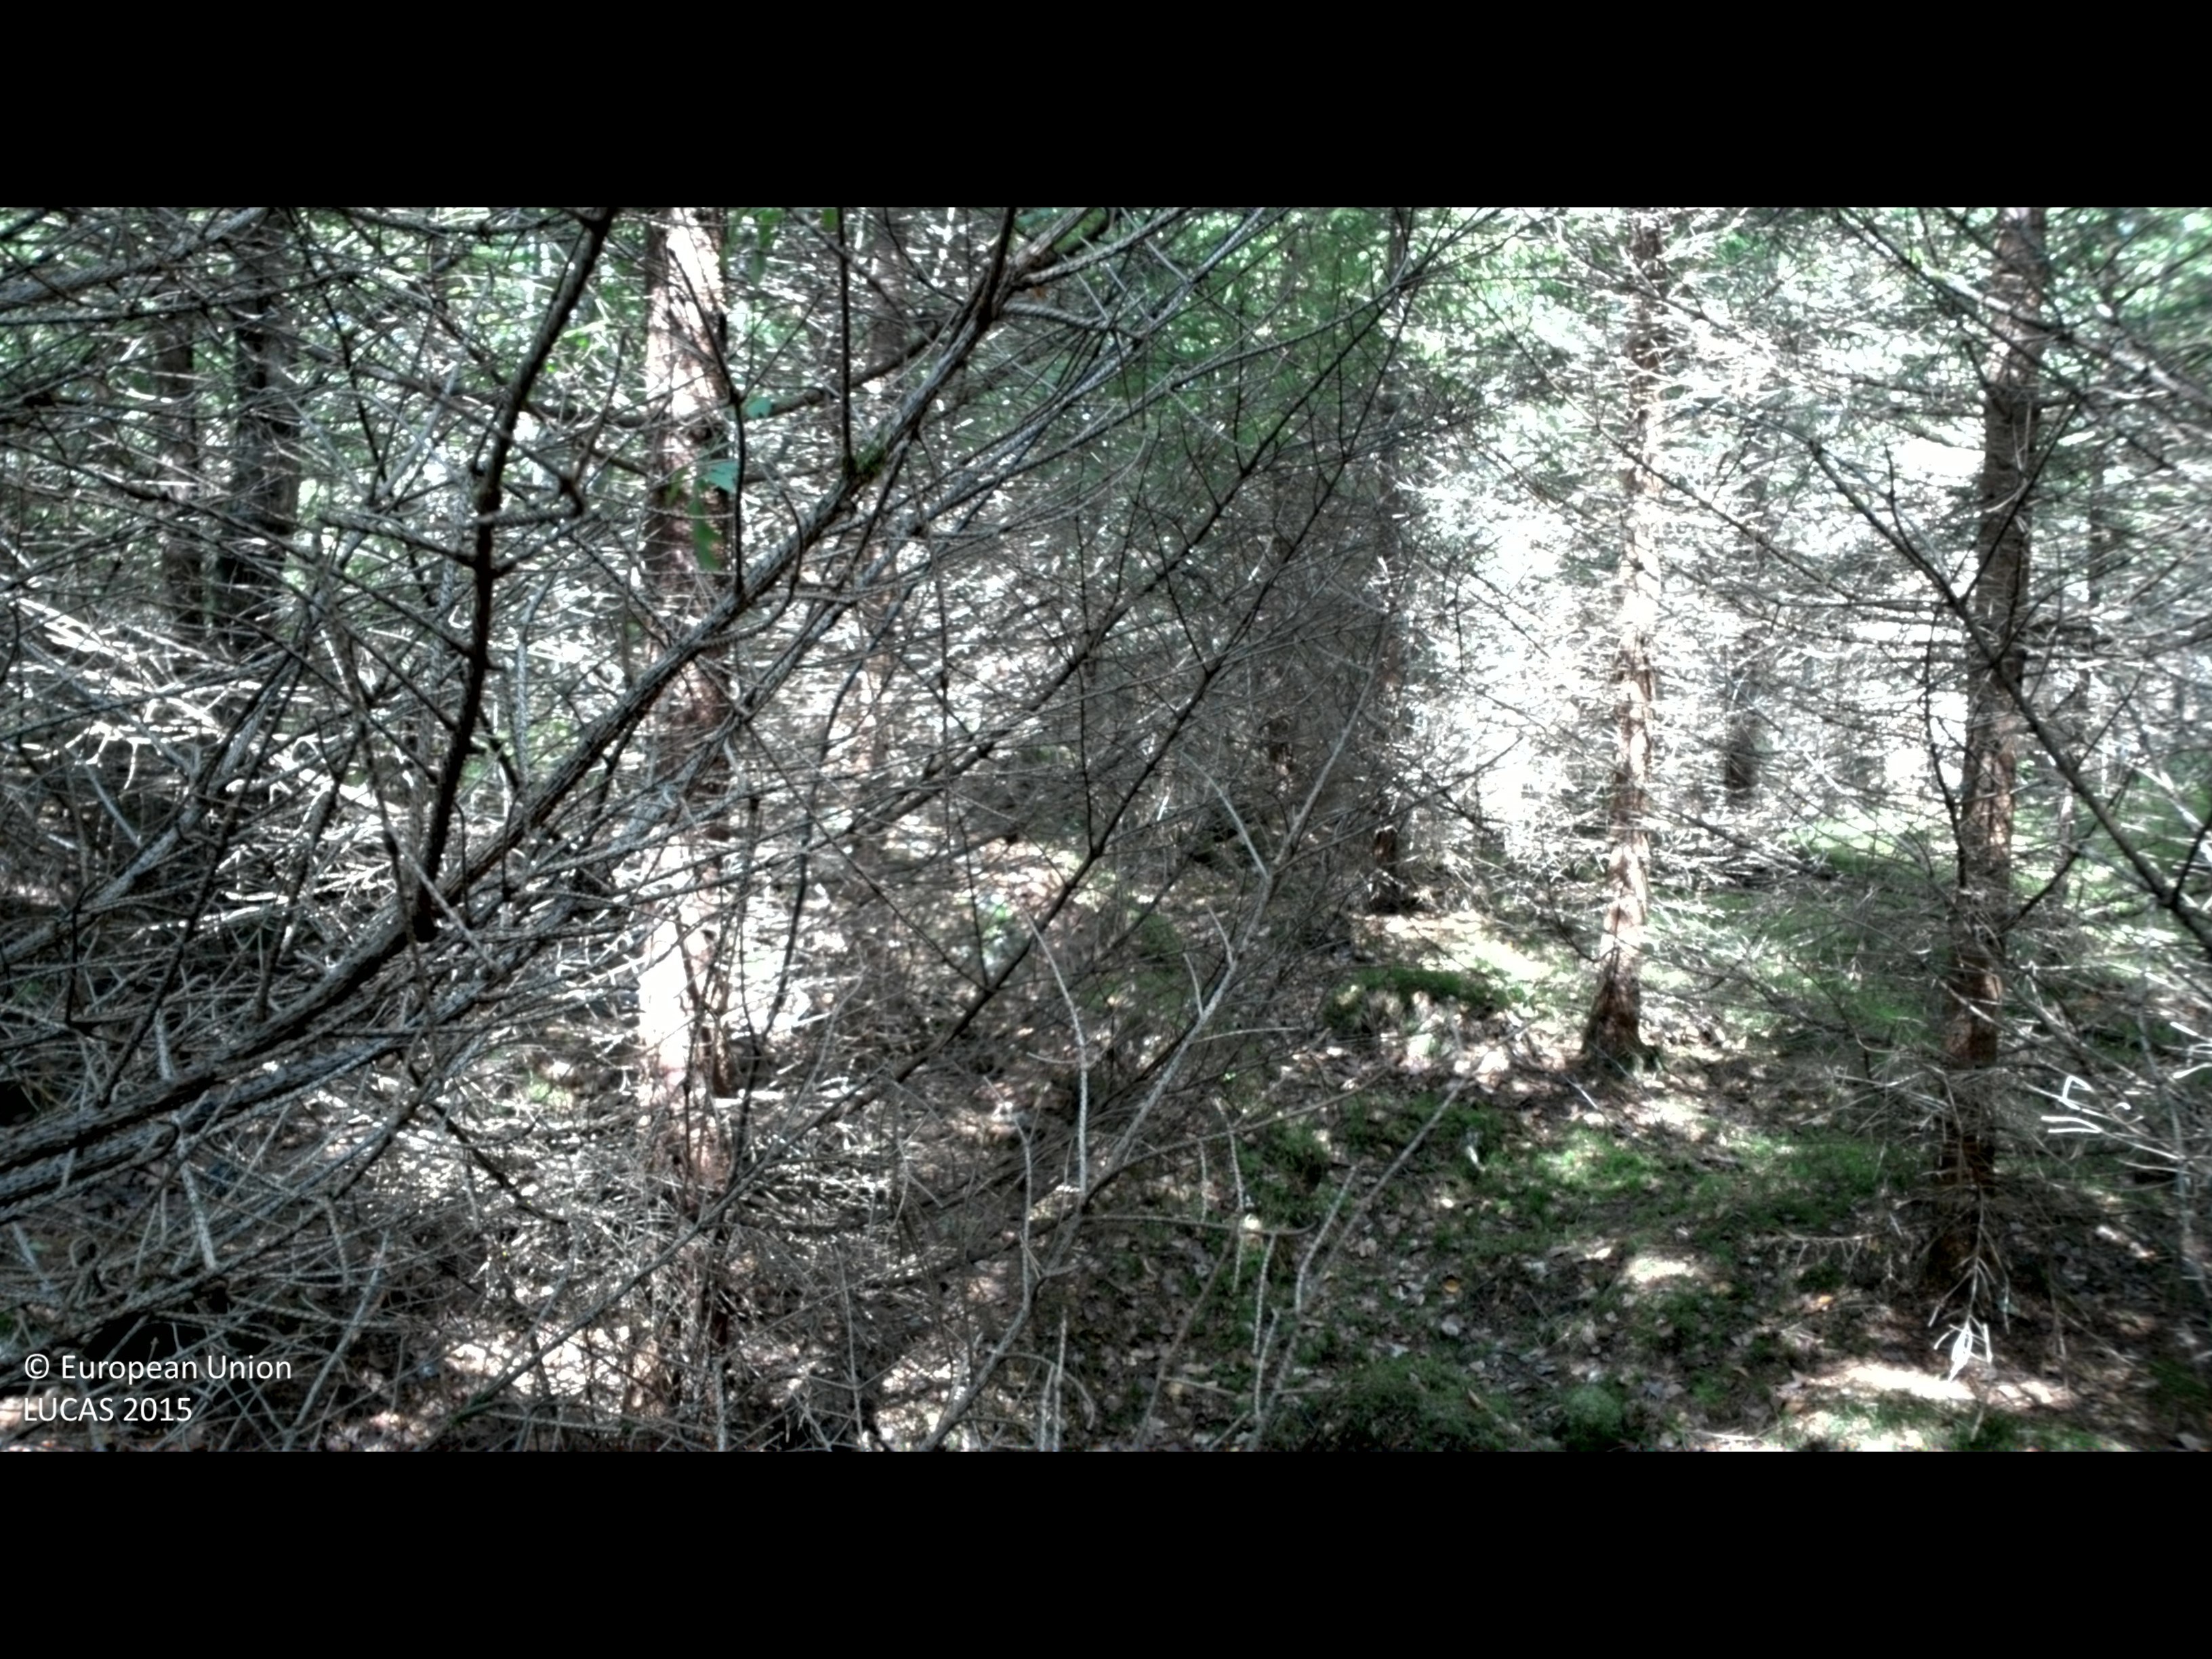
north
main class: Woodland
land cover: Spruce dominated coniferous woodland
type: boreal forest
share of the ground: > 75 %
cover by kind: coniferous forest trees 90 %, lichens and mosses 10 %
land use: Forestry
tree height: < 5 m
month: August
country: SE
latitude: 56.3953
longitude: 14.5501
